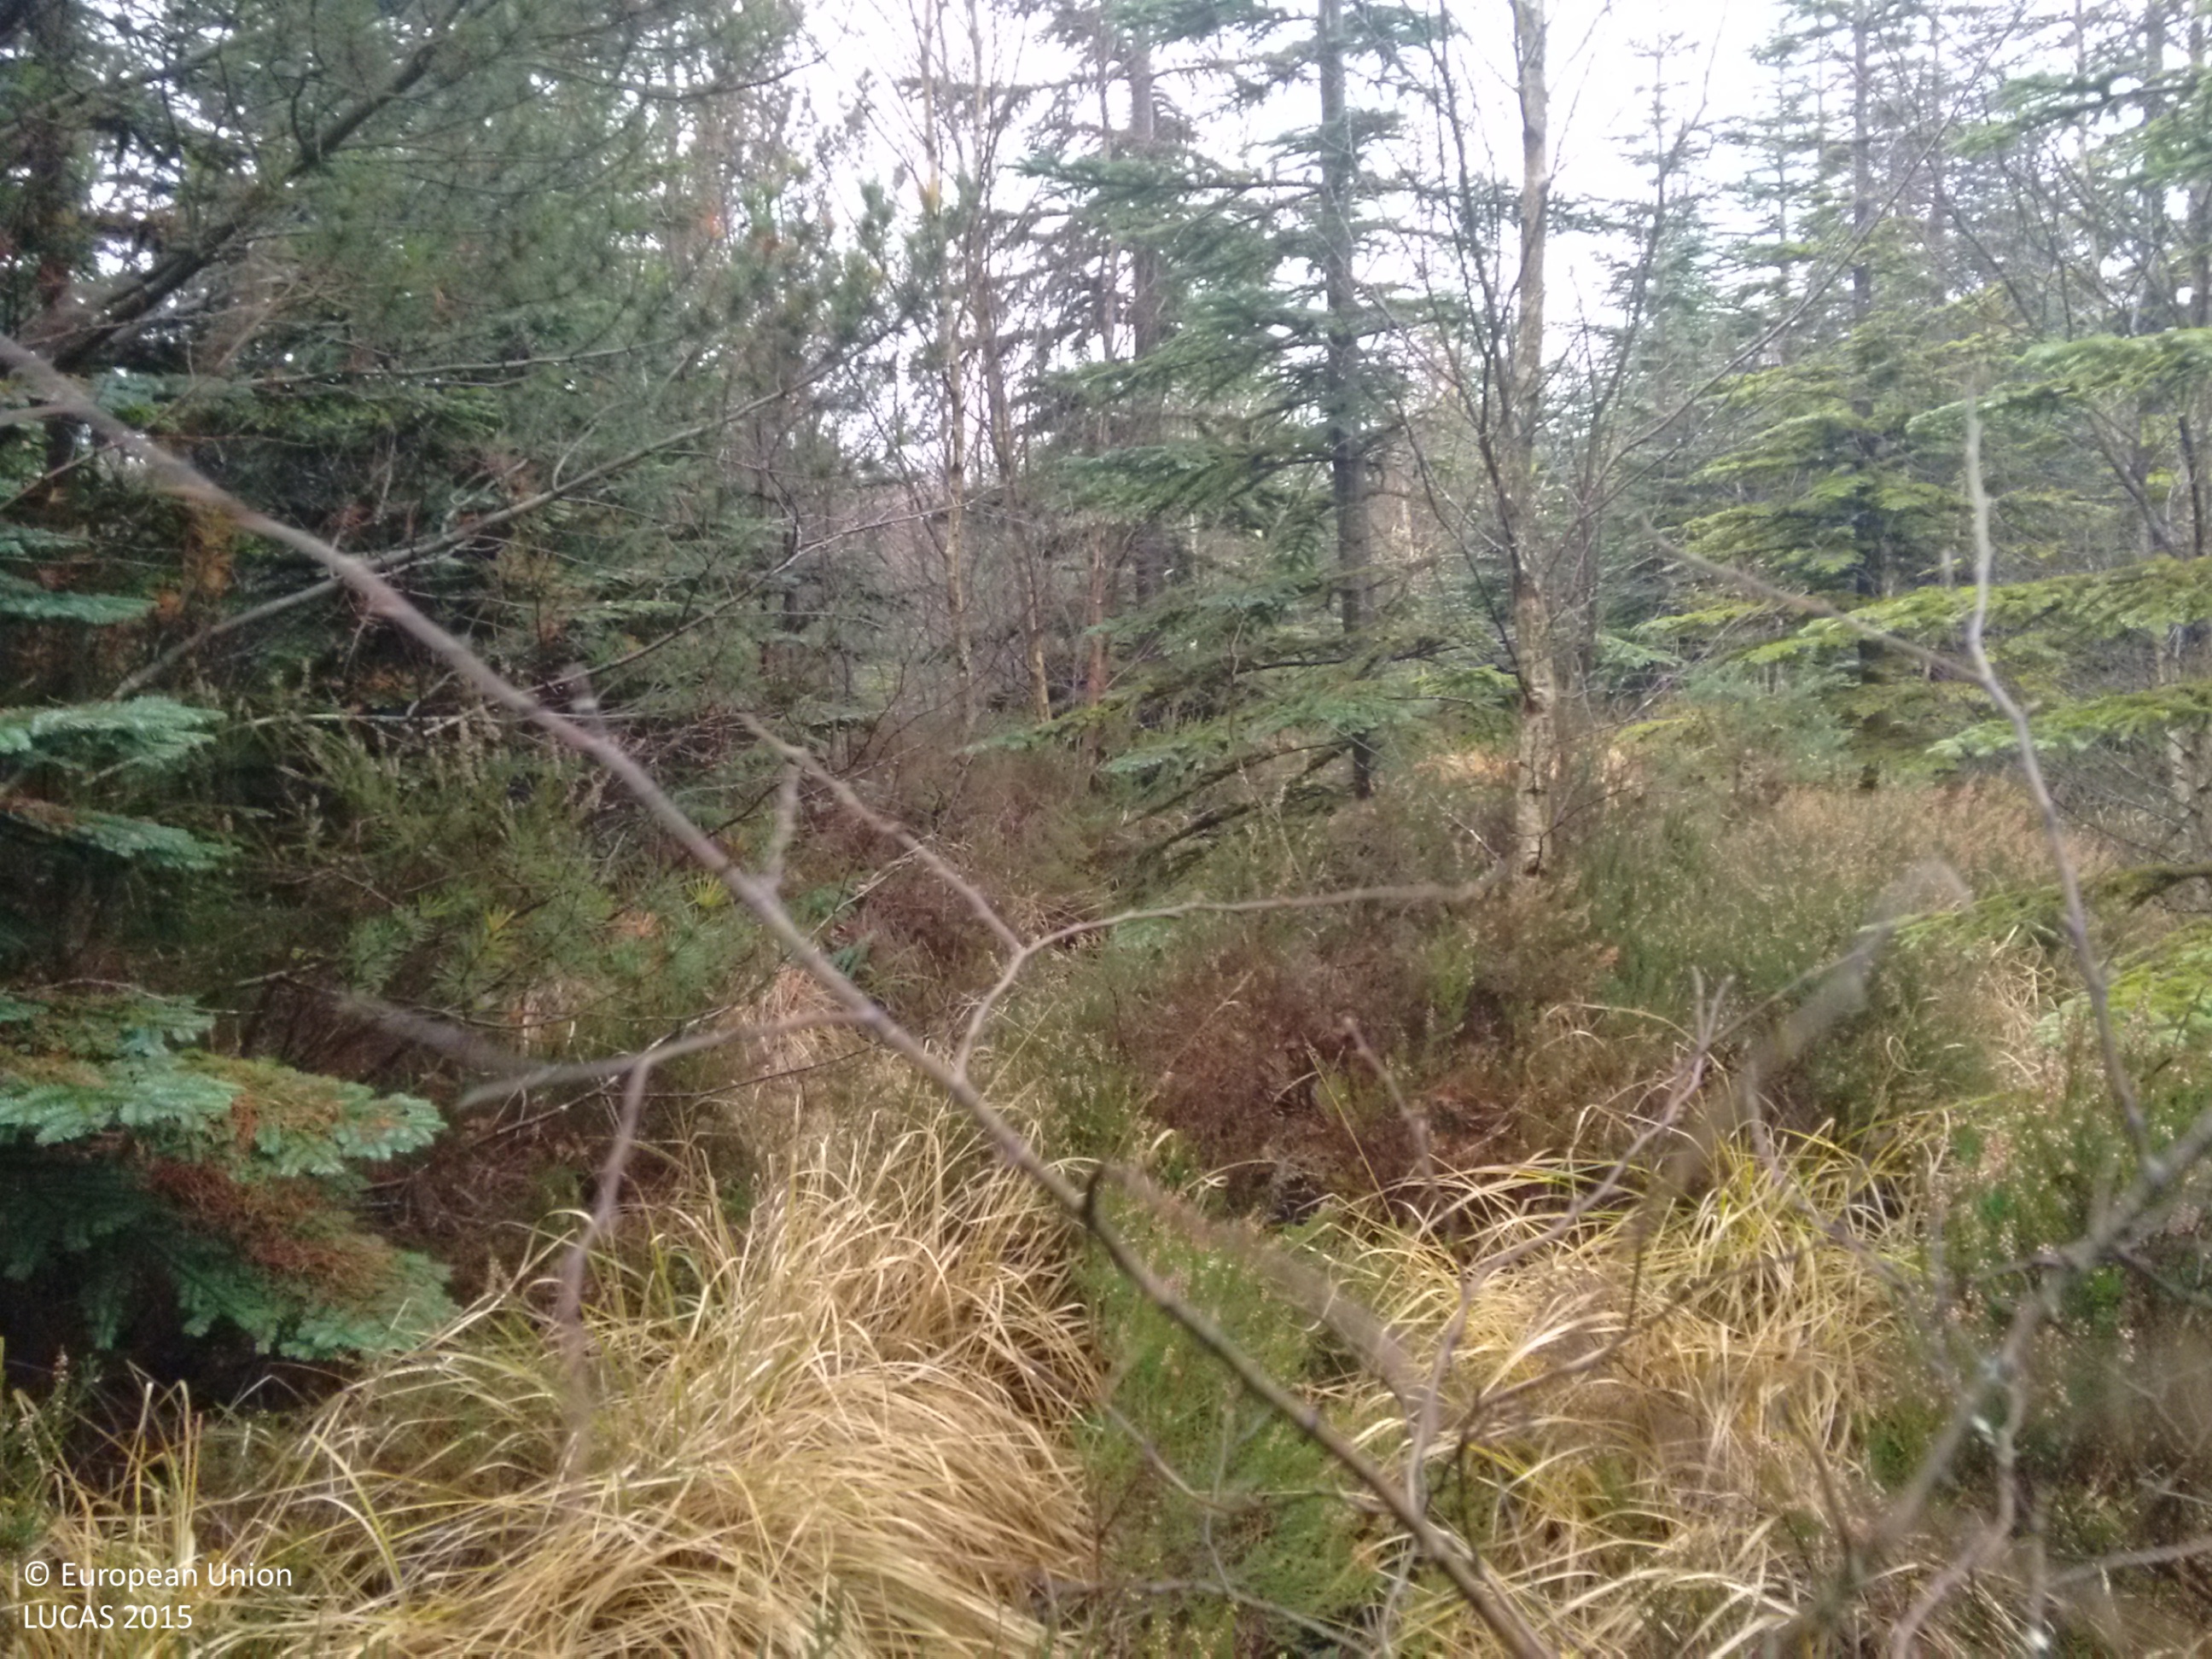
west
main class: Woodland
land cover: Pine dominated coniferous woodland
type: exotic forest
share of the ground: > 75 %
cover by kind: coniferous forest trees 100 %
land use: Forestry
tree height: > 5 m
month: November
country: GB
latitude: 52.9511
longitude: -4.2846
